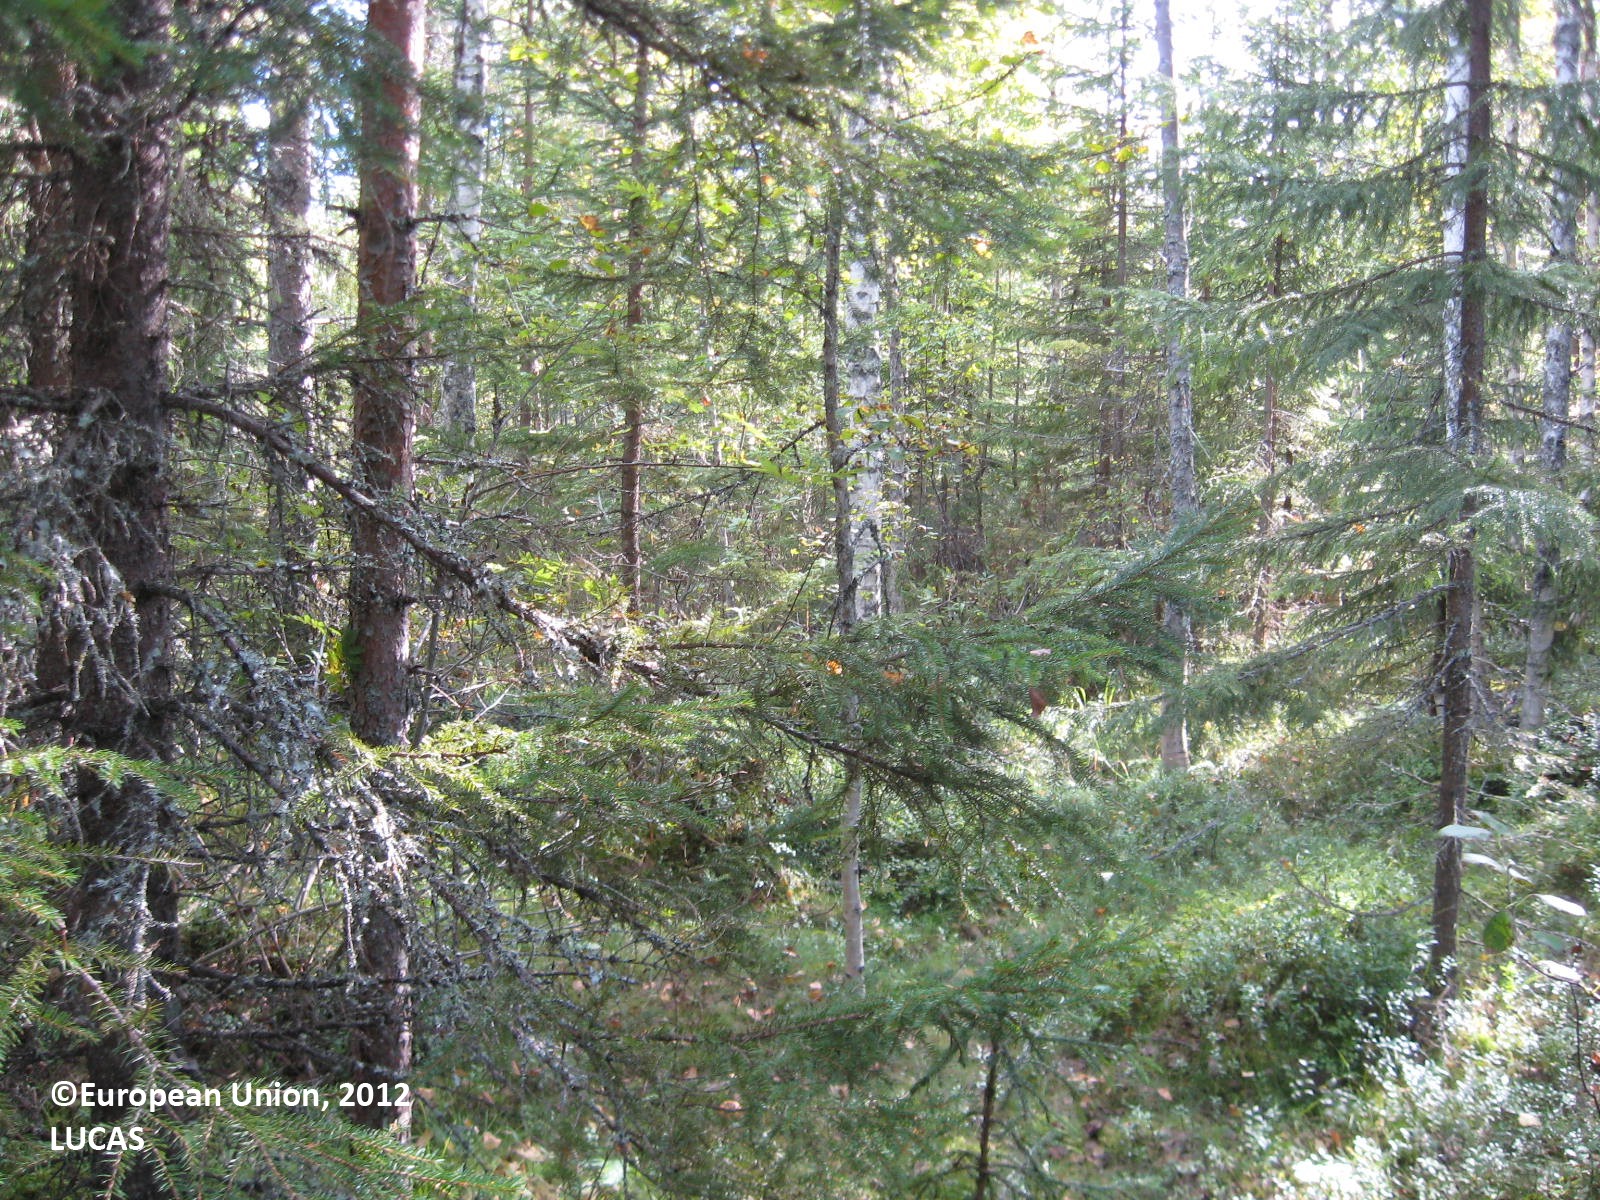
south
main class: Woodland
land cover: Other mixed woodland
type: boreal forest
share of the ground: > 75 %
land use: Forestry
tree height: > 5 m
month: August
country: FI
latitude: 63.6898
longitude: 29.6647
